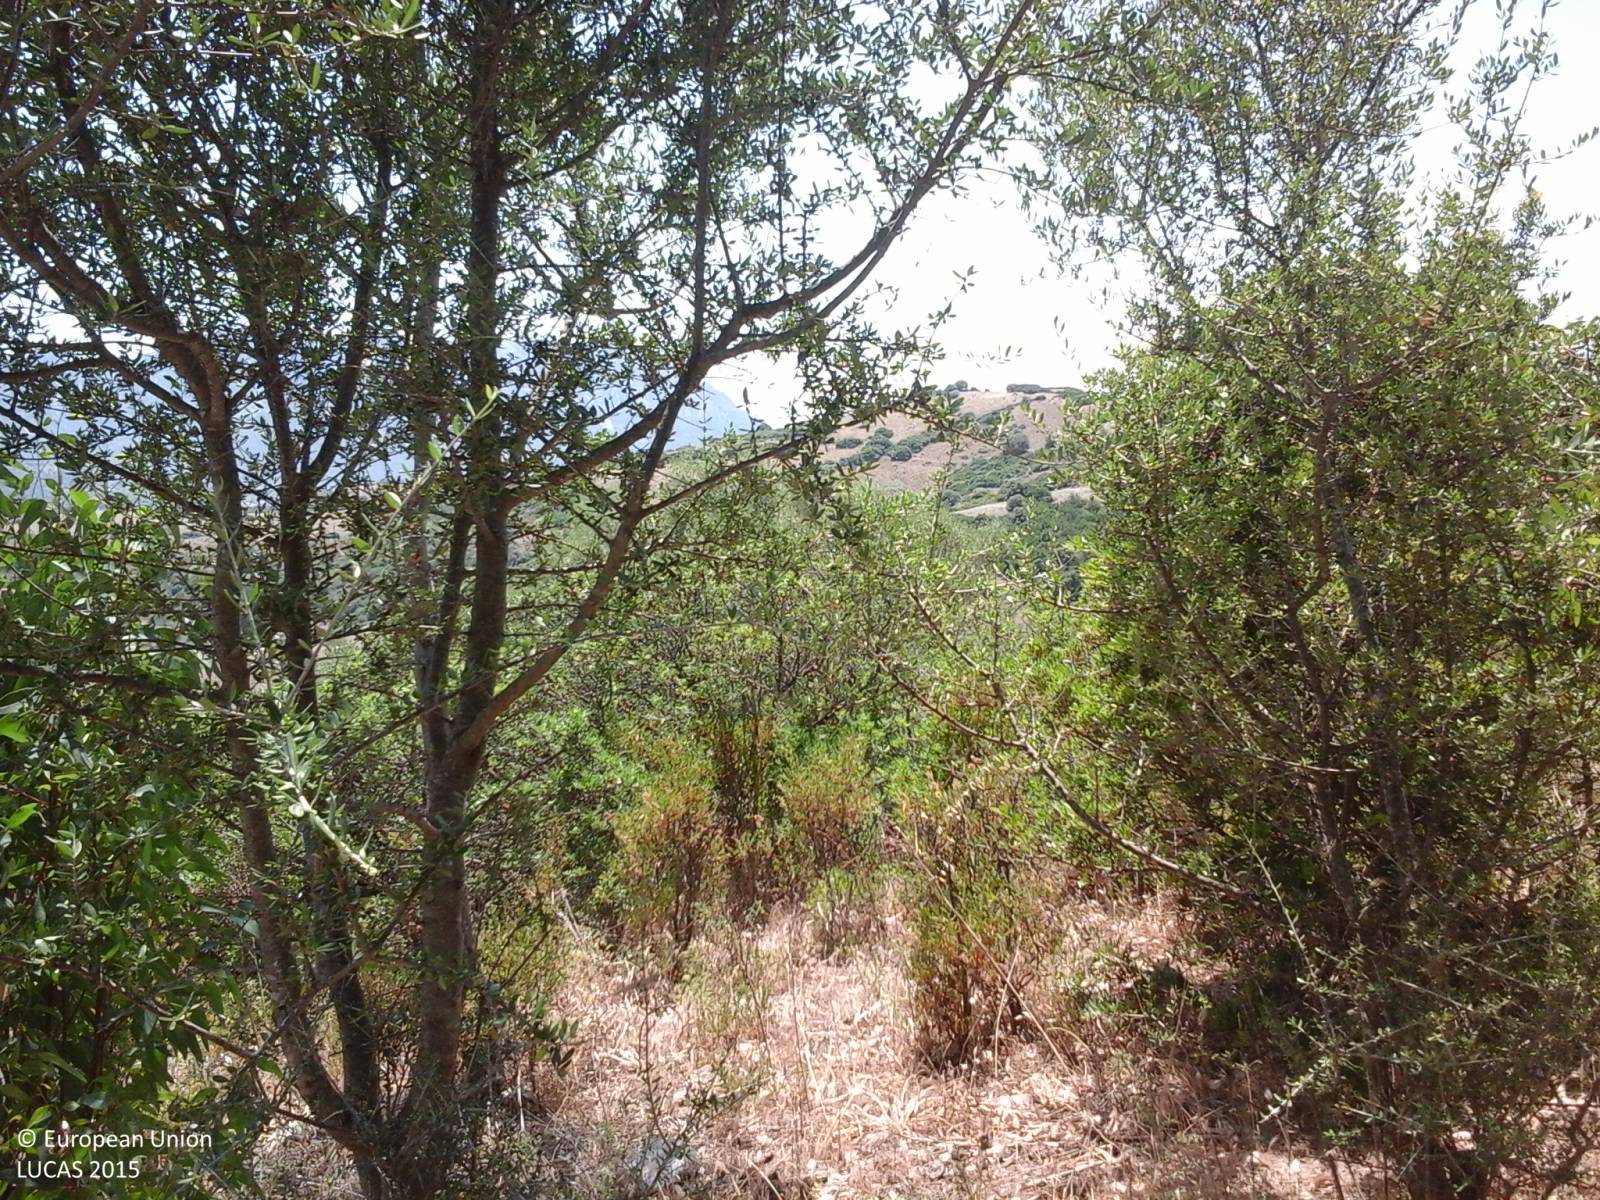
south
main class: Woodland
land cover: Broadleaved woodland
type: broadleaved evergreen forest
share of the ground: > 75 %
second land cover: Grassland without tree/shrub cover
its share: > 75 %
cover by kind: broadleaved forest trees 95 %, herbaceous plants 5 %
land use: Forestry
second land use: Agriculture (excluding fallow land and kitchen gardens)
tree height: > 5 m
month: June
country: IT
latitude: 40.4477
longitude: 9.6364
